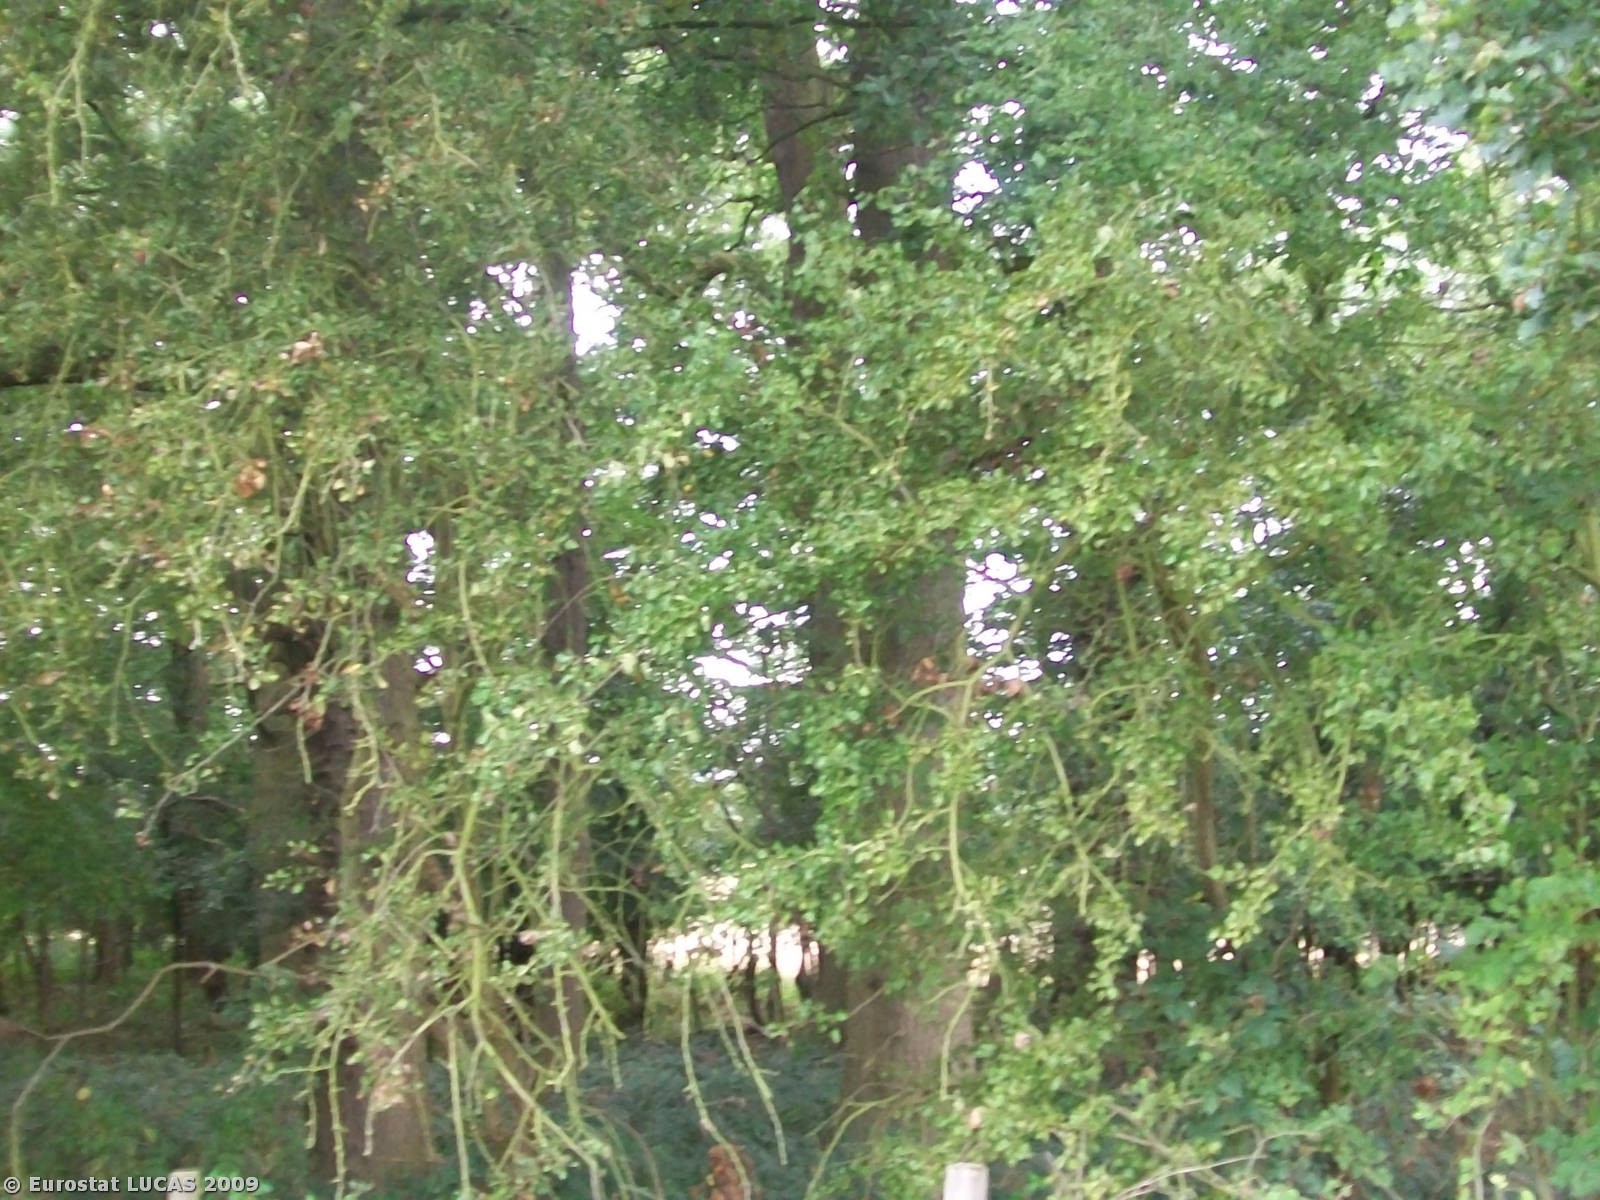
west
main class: Grassland
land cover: Grassland without tree/shrub cover
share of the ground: > 75 %
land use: Agriculture (excluding fallow land and kitchen gardens)
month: September
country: GB
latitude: 51.6770
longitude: 0.1492
